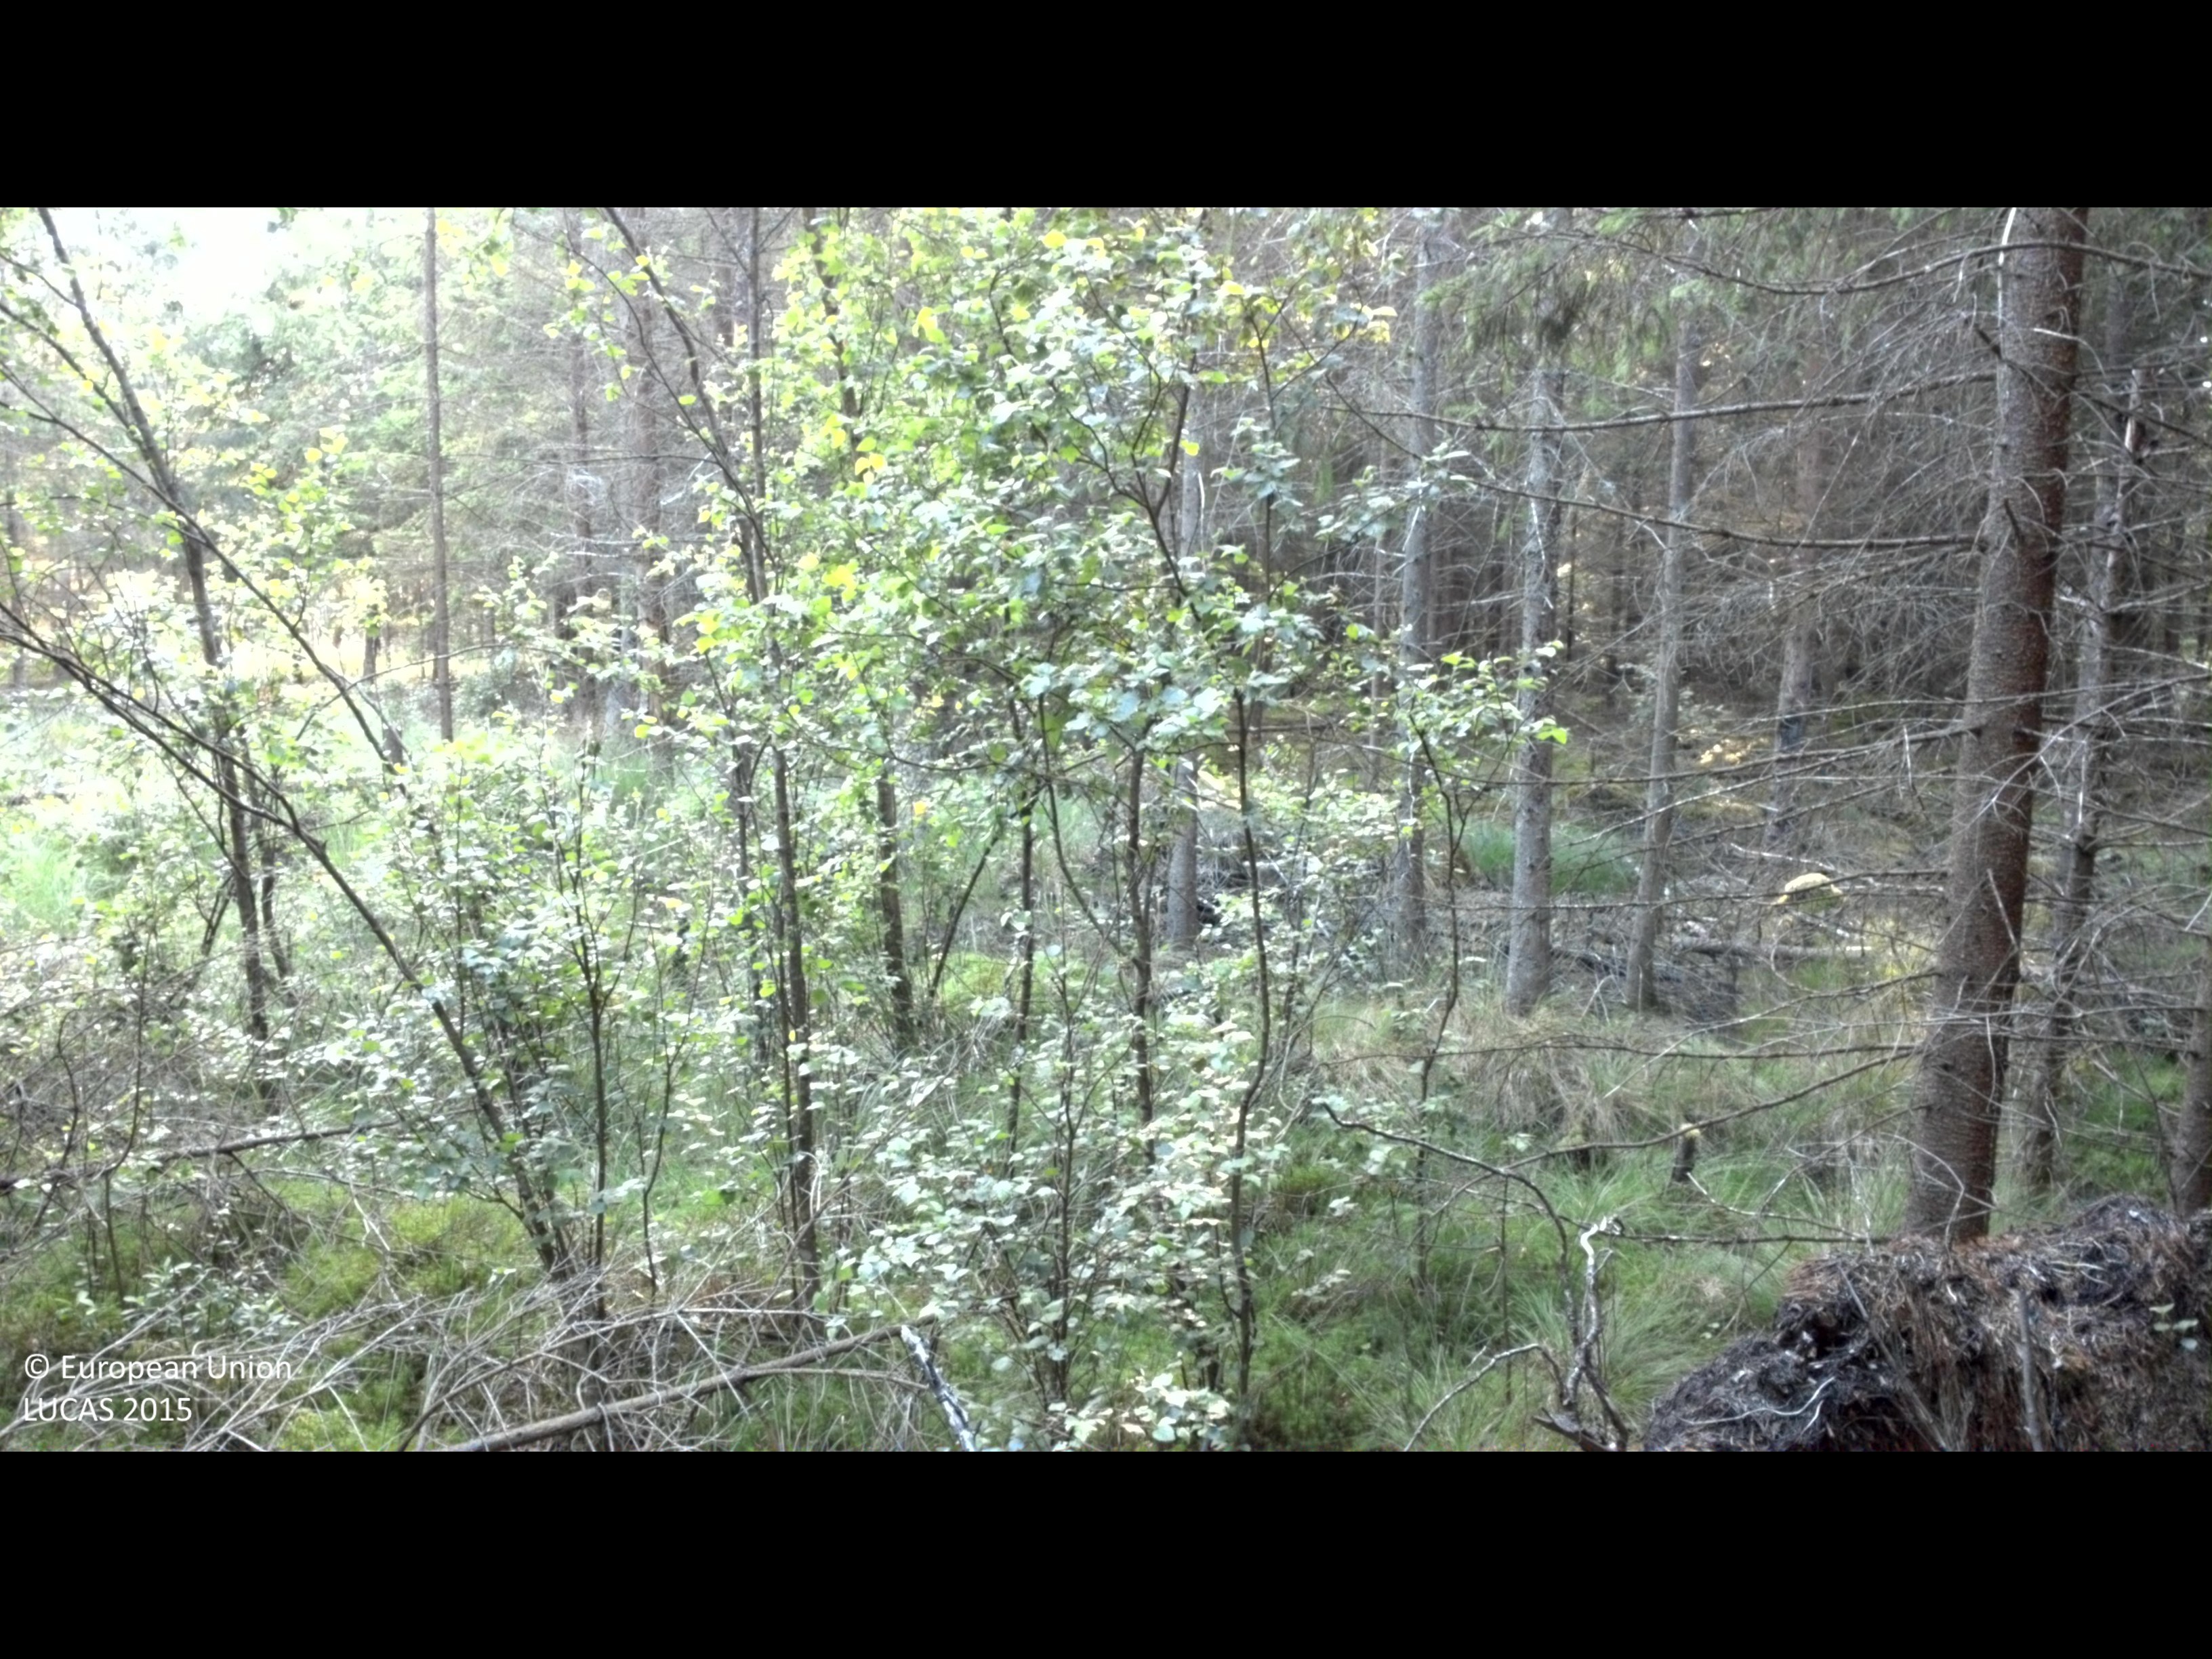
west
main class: Woodland
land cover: Spruce dominated coniferous woodland
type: boreal forest
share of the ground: > 75 %
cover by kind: coniferous forest trees 75 %, herbaceous plants 10 %, broadleaved forest trees 5 %, shrubs 5 %, lichens and mosses 5 %
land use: Forestry
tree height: > 5 m
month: July
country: SE
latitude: 56.4970
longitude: 14.2045
